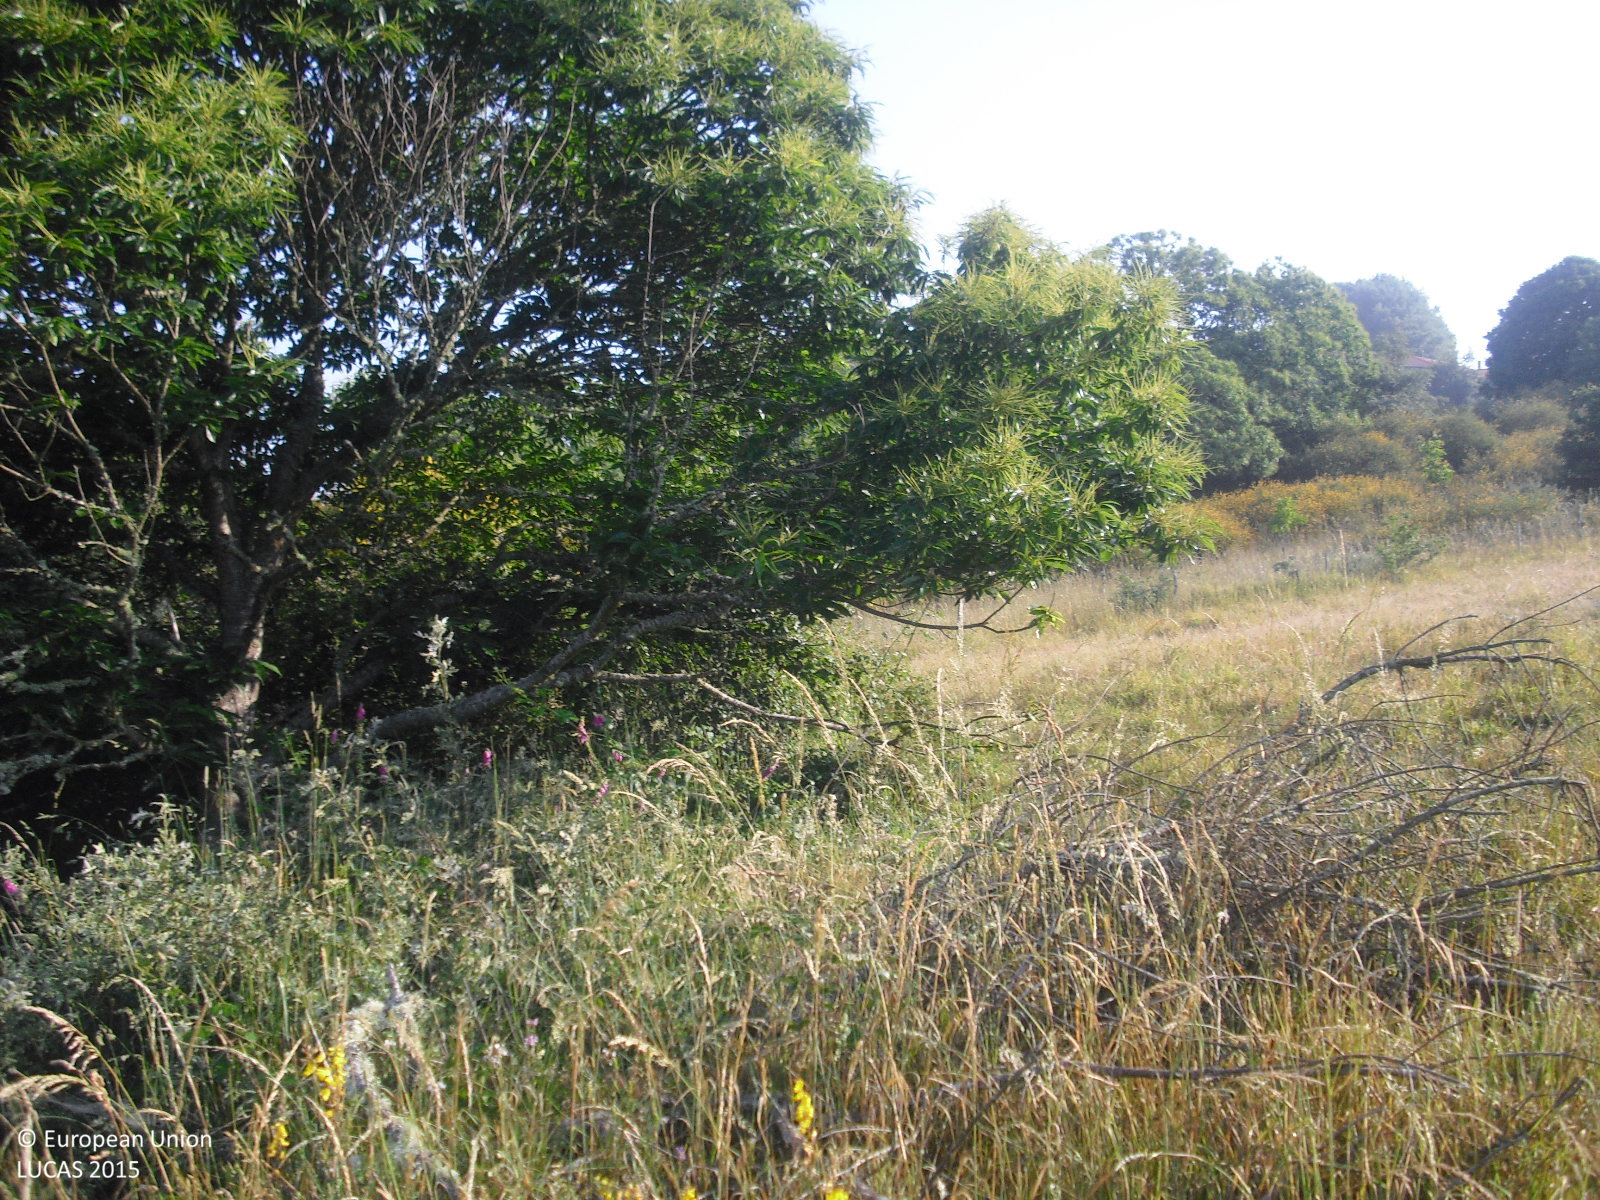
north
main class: Shrubland
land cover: Shrubland without tree cover
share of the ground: 25 - 50 %
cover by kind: herbaceous plants 60 %, shrubs 40 %
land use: Agriculture (excluding fallow land and kitchen gardens)
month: June
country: ES
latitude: 42.5084
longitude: -7.7597
